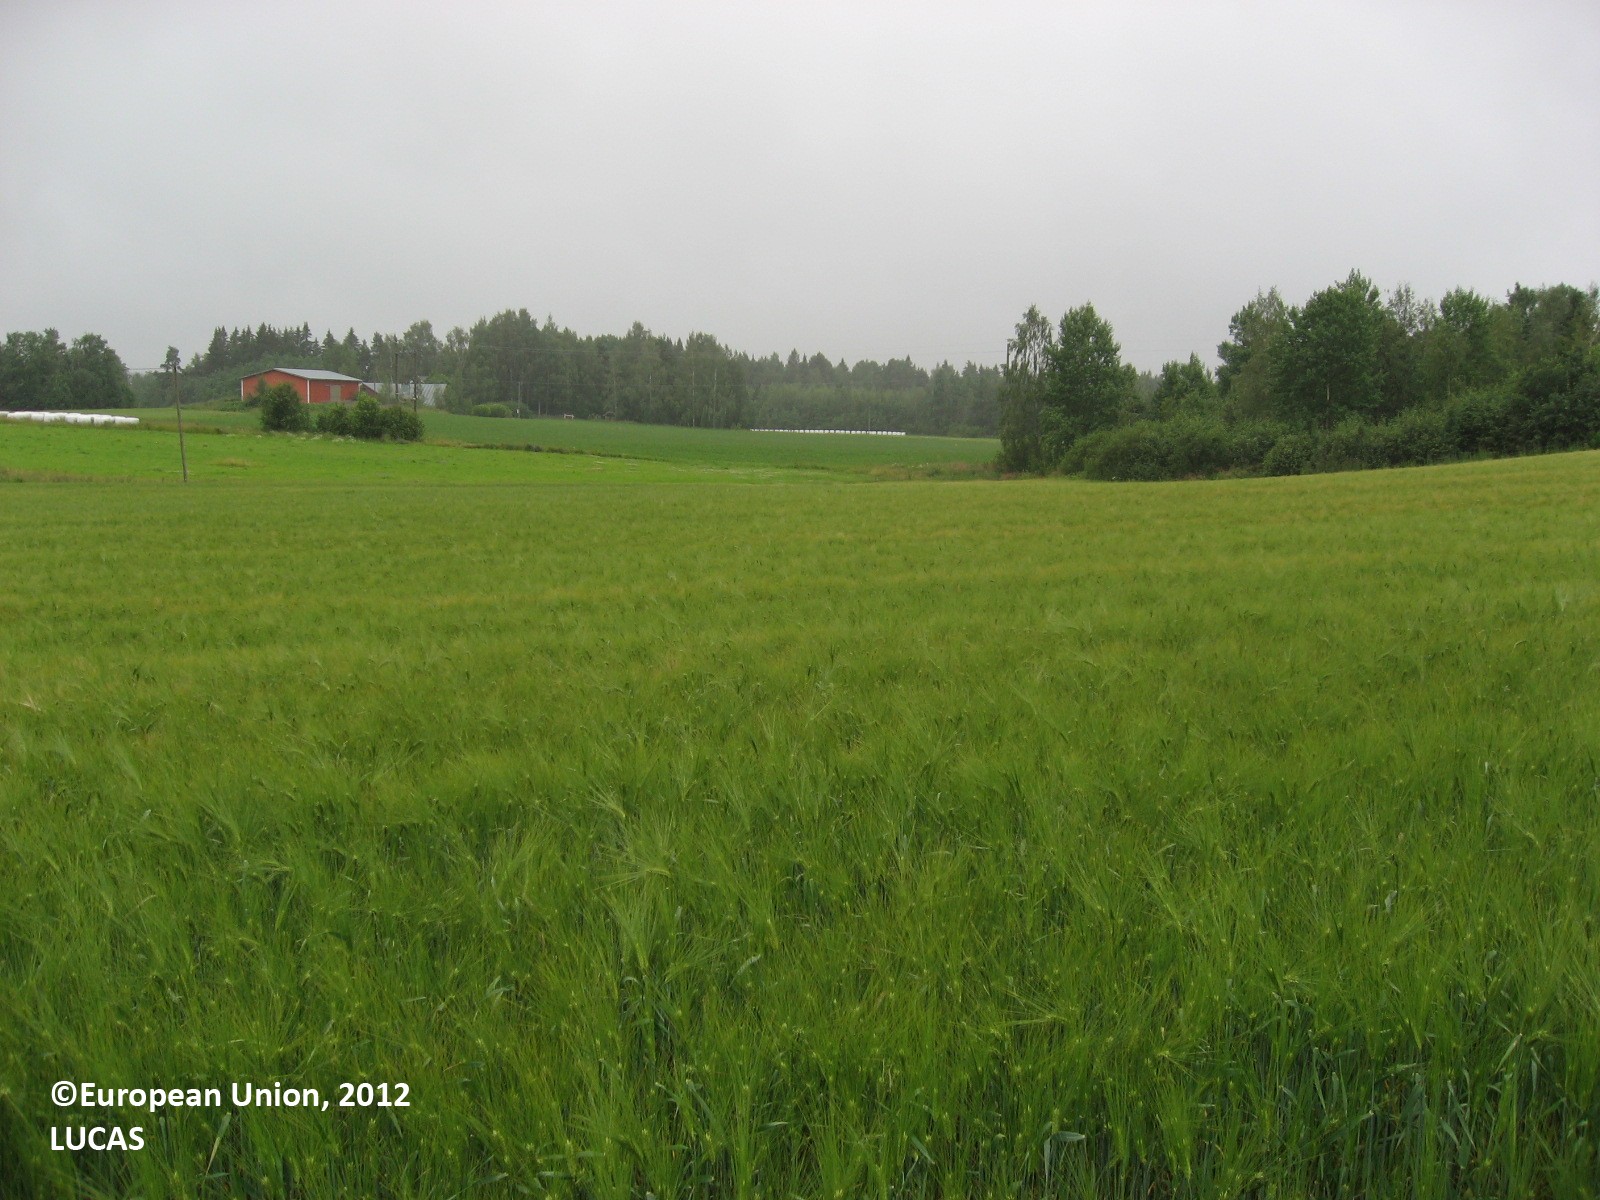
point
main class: Cropland
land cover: Barley
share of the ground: > 75 %
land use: Agriculture (excluding fallow land and kitchen gardens)
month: July
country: FI
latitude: 61.1168
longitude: 25.7004
